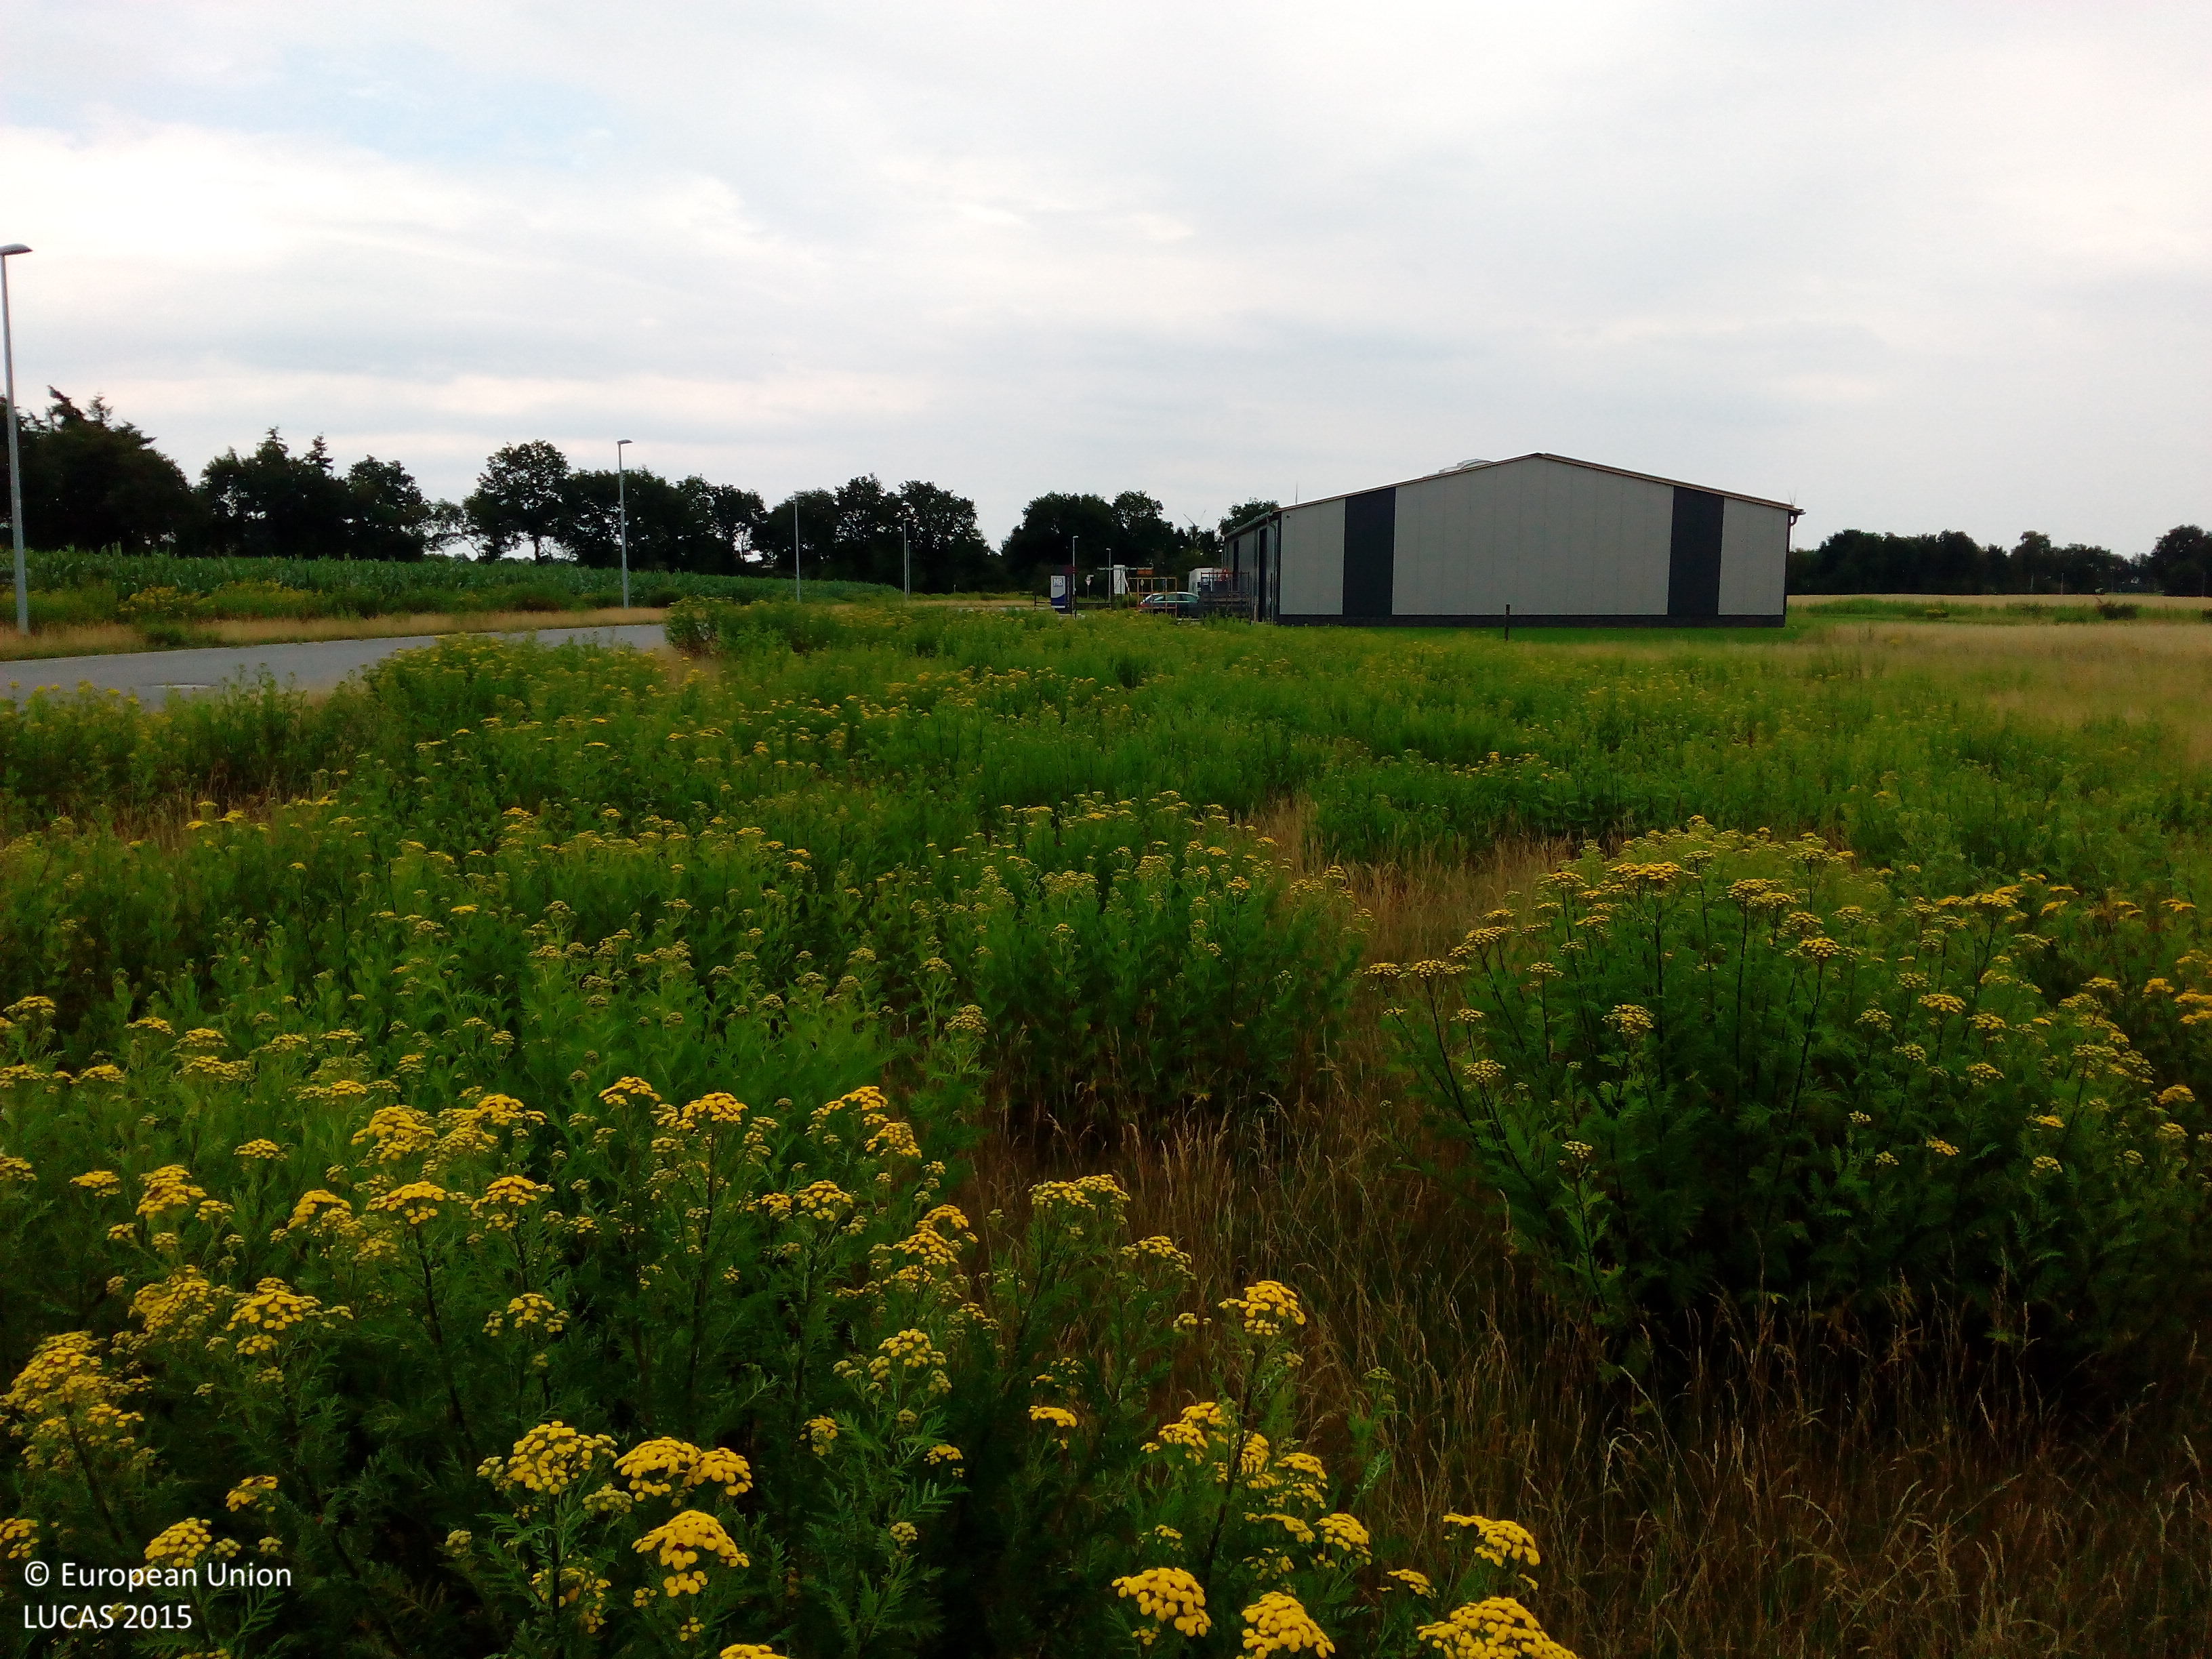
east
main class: Grassland
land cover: Spontaneously vegetated surfaces
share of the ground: > 75 %
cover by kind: herbaceous plants 100 %
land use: Fallow land
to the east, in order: Spontaneously vegetated surfaces; Grassland without tree/shrub cover; Artificial constructions in urban areas; Spontaneously vegetated surfaces; Paved roads, cycling and walking lanes; Broadleaved woodland; Electric lines; Railways; Broadleaved woodland; Rye; Fences; Broadleaved woodland
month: July
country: DE
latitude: 52.9892
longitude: 7.9597
